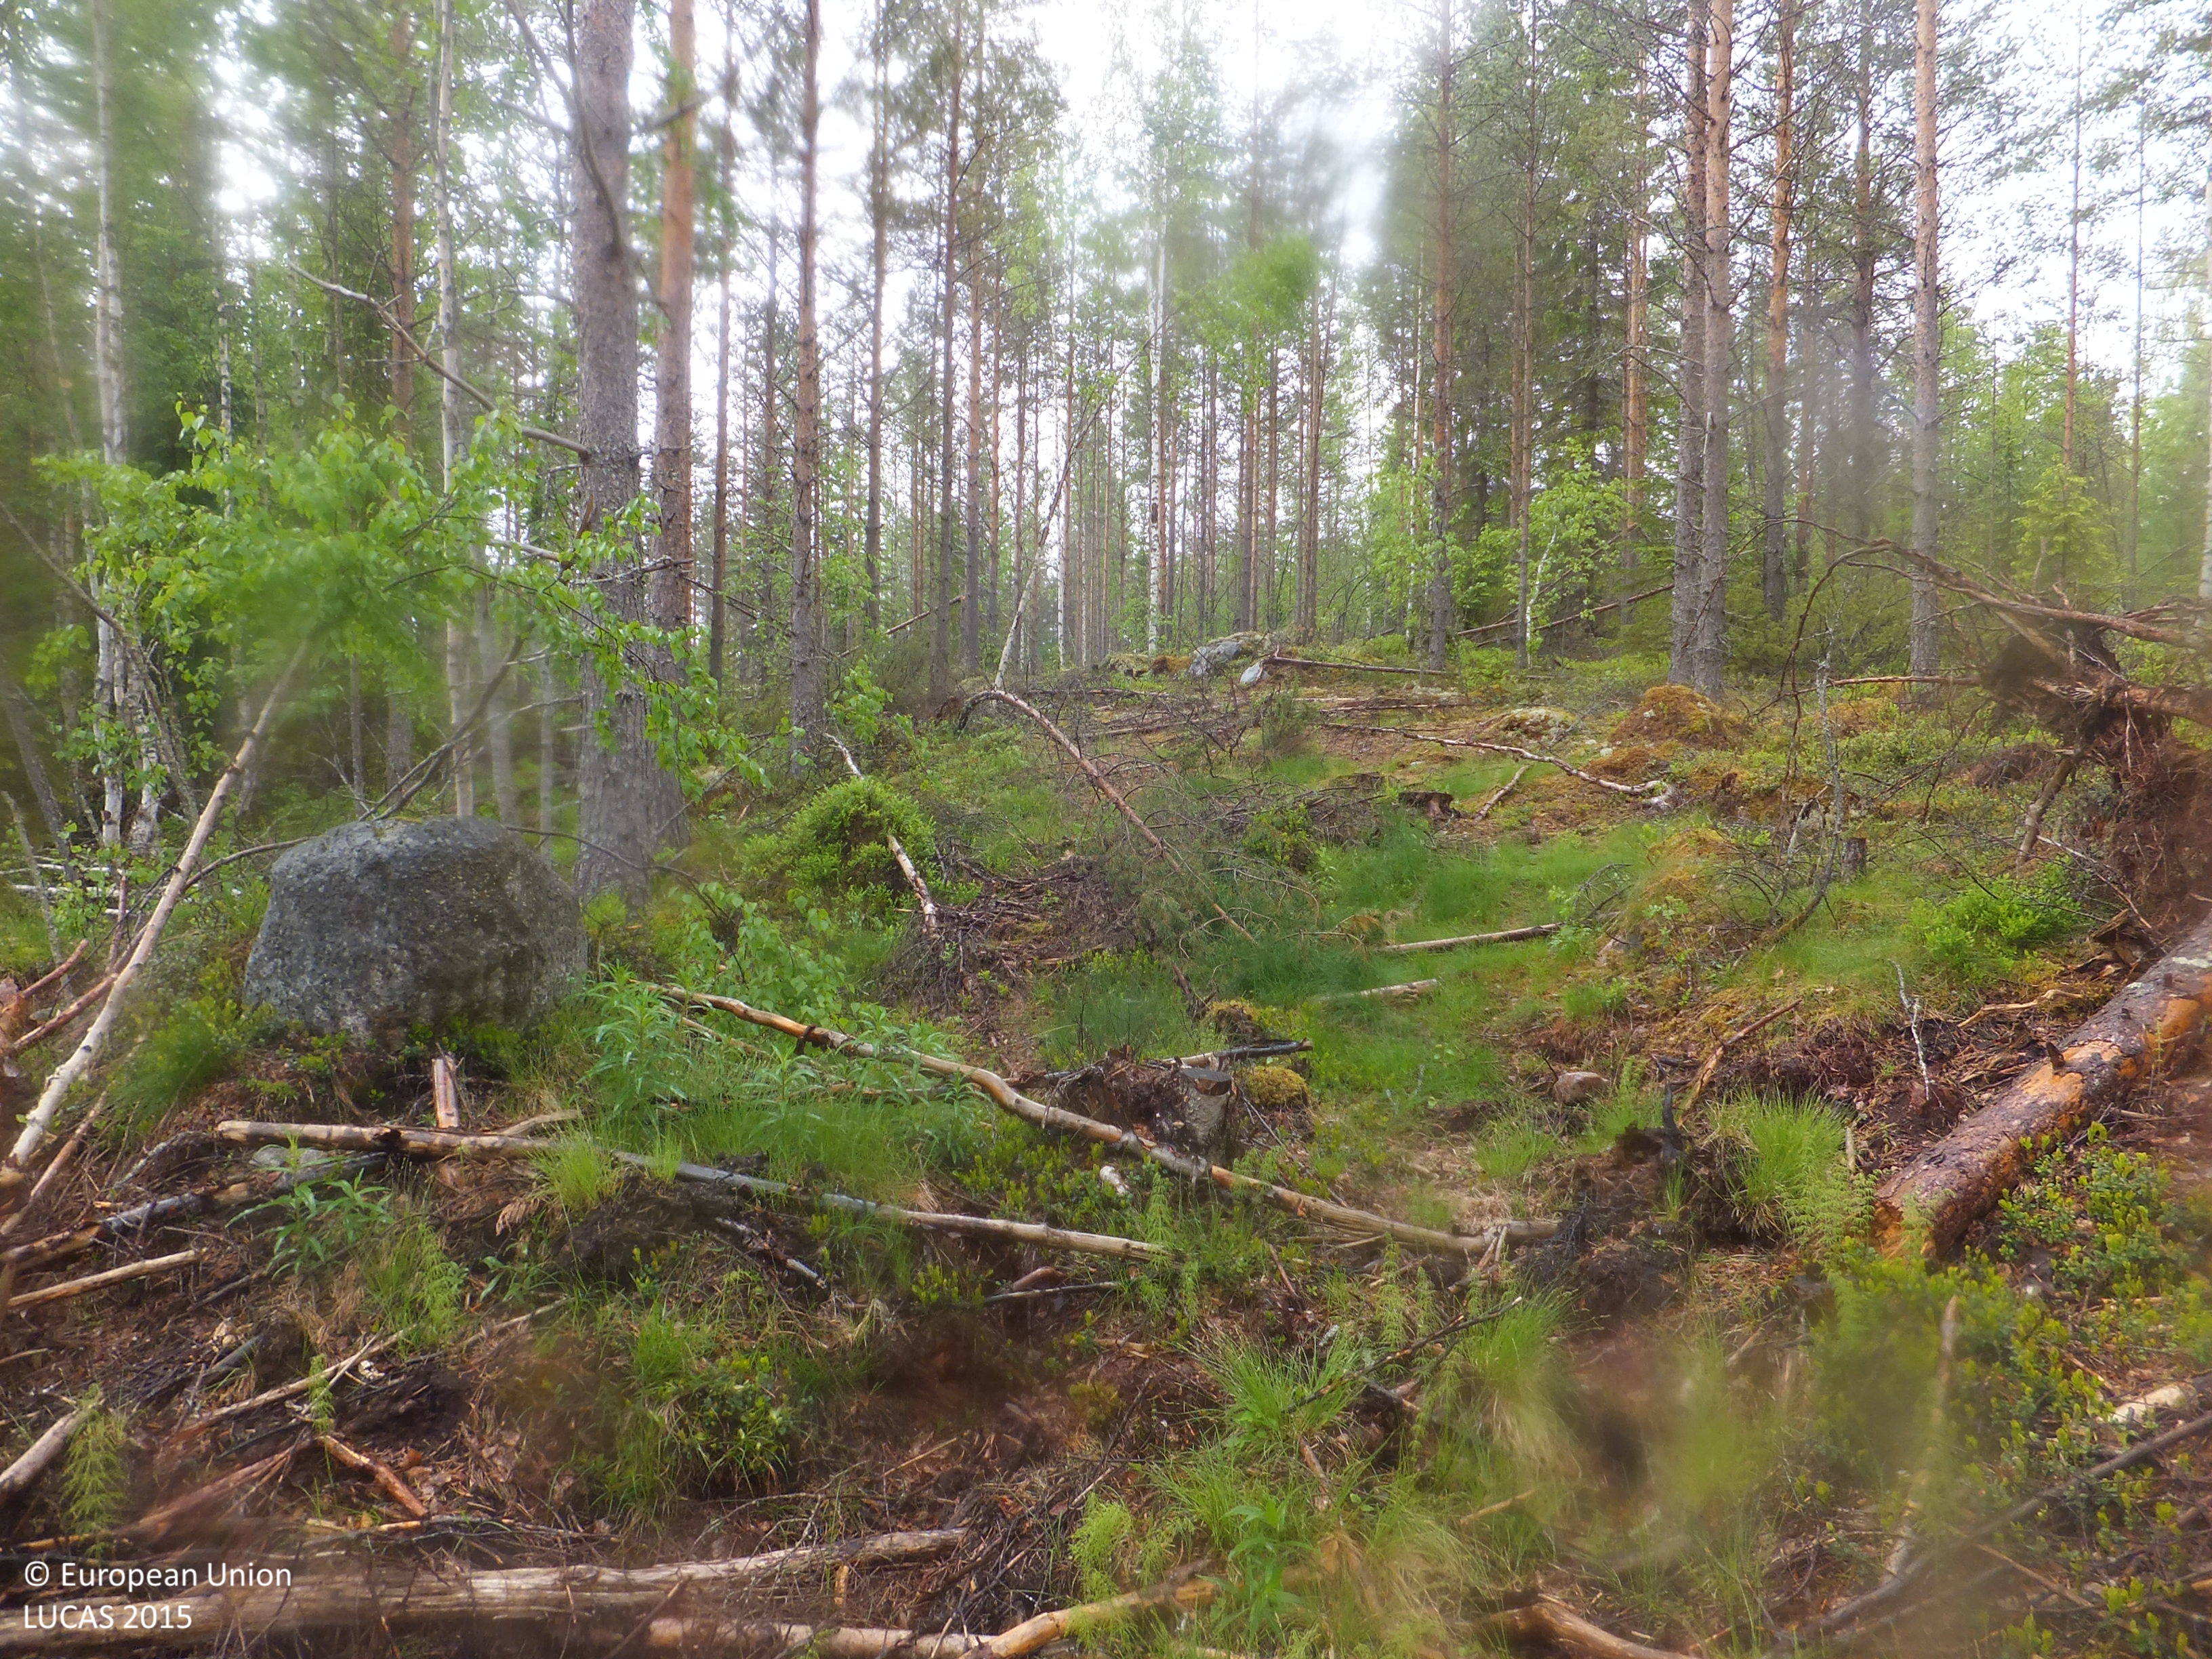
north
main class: Woodland
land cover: Pine dominated mixed woodland
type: boreal forest
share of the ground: 50 - 75 %
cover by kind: coniferous forest trees 30 %, broadleaved forest trees 30 %, herbaceous plants 15 %, shrubs 10 %, lichens and mosses 10 %, unconsolidated bare surface 5 %
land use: Forestry
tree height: > 5 m
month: June
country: FI
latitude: 63.7273
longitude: 24.8873
